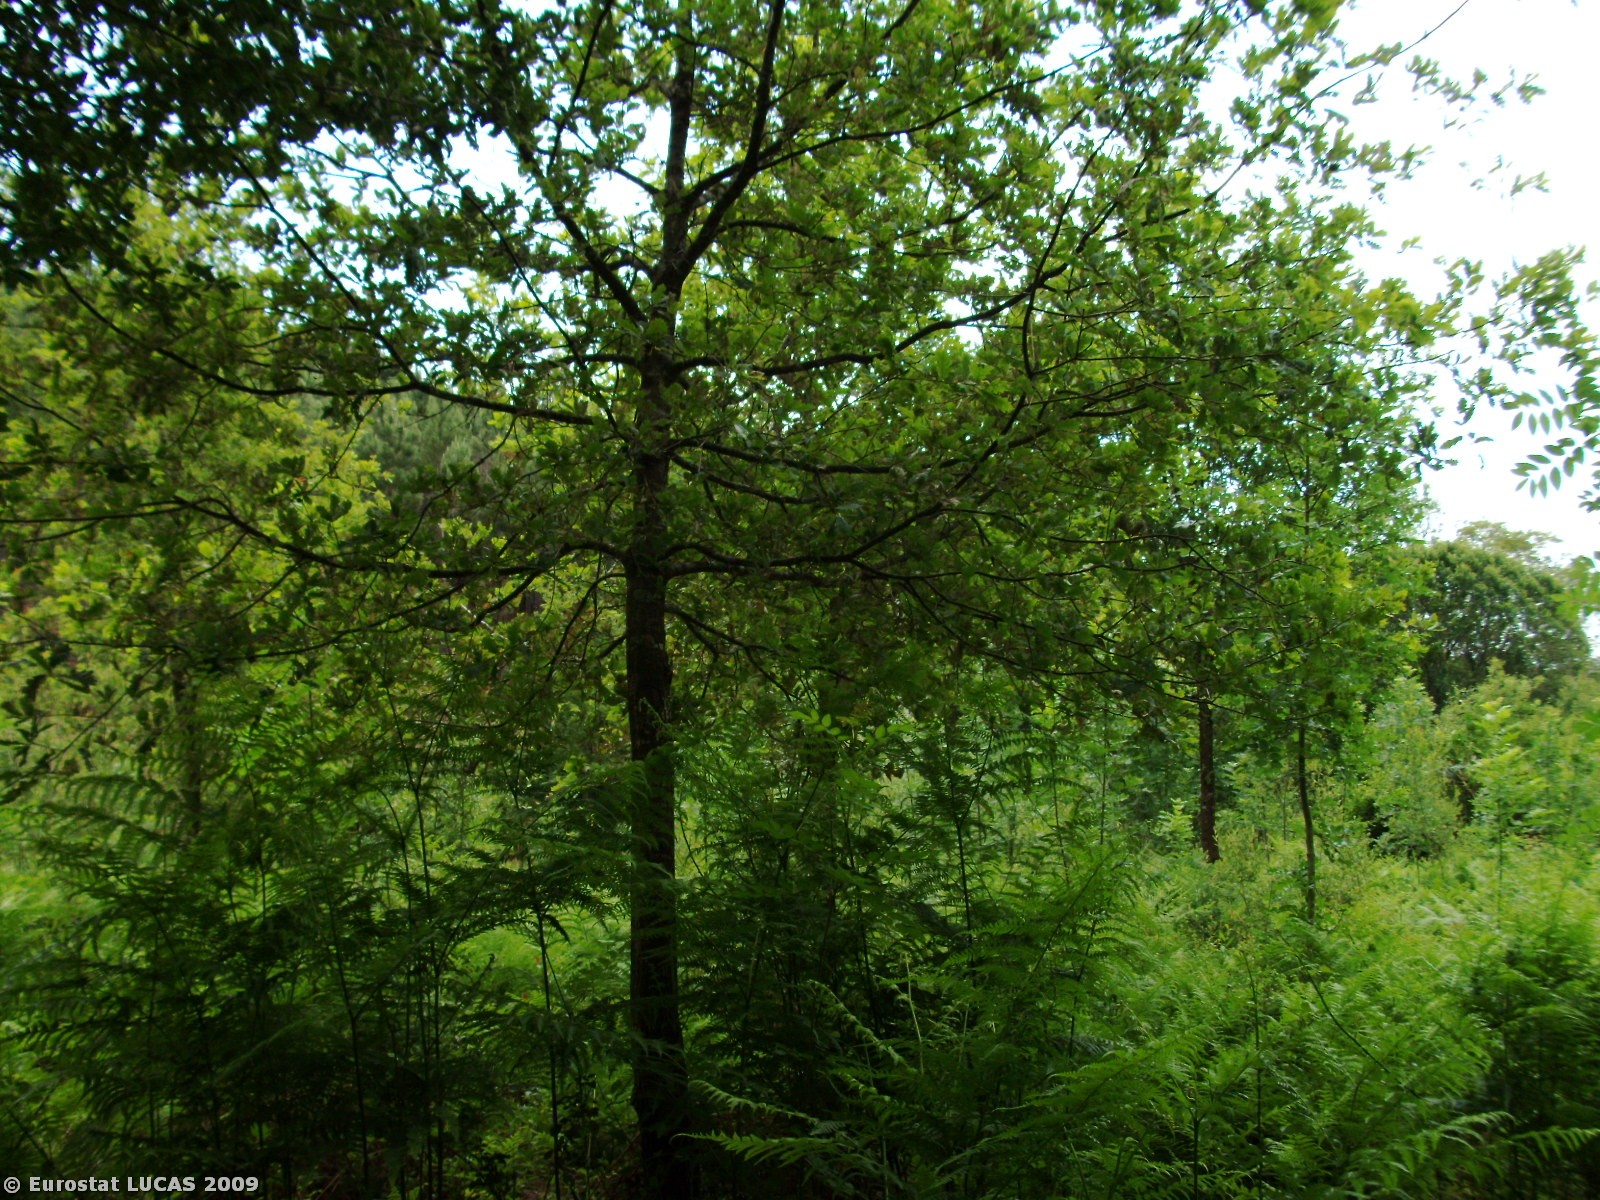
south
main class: Woodland
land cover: Broadleaved woodland
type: mesophytic deciduous forest
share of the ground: 50 - 75 %
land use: Forestry
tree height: > 5 m
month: June
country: PT
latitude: 39.9617
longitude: -8.1586
